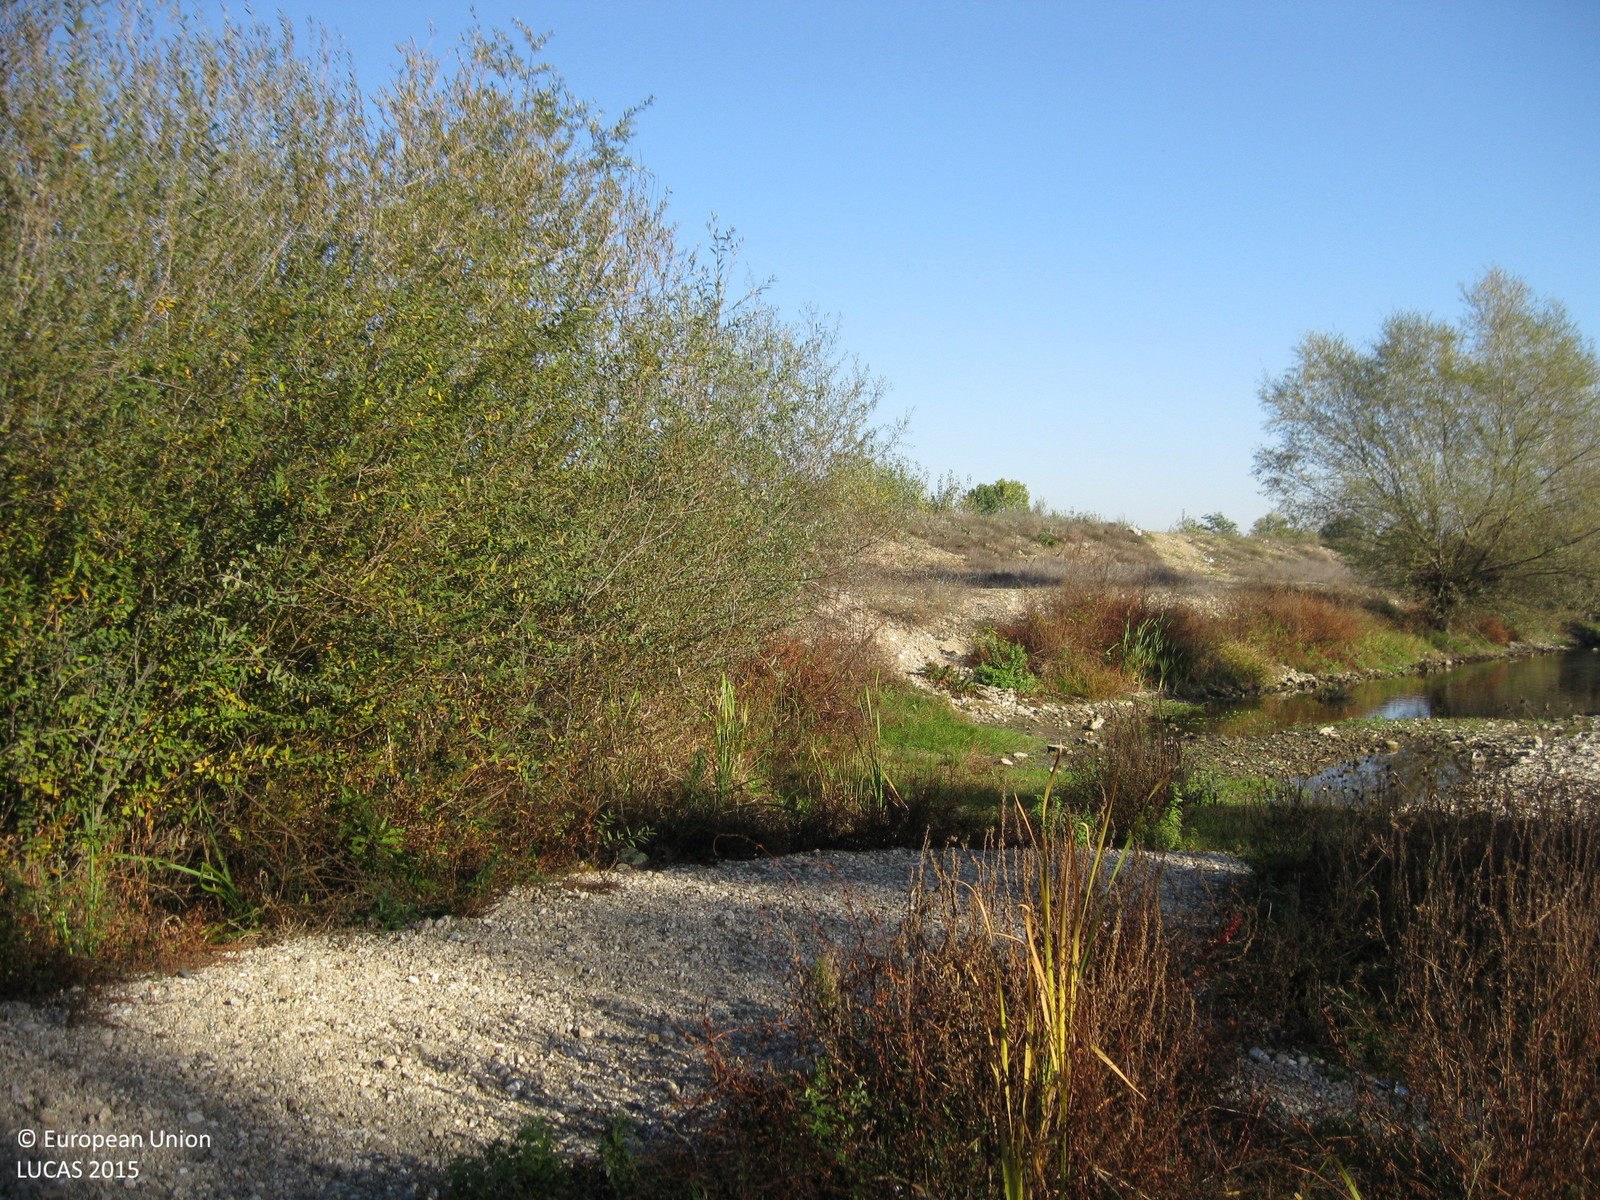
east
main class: Shrubland
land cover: Shrubland without tree cover
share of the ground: 25 - 50 %
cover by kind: herbaceous plants 65 %, shrubs 35 %
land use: Semi-natural and natural areas not in use
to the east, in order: Shrubland without tree cover; Sand; Tracks; Grassland without tree/shrub cover; Shrubland with sparse tree cover; Grassland without tree/shrub cover
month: November
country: BG
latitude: 42.2856
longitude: 24.2206
